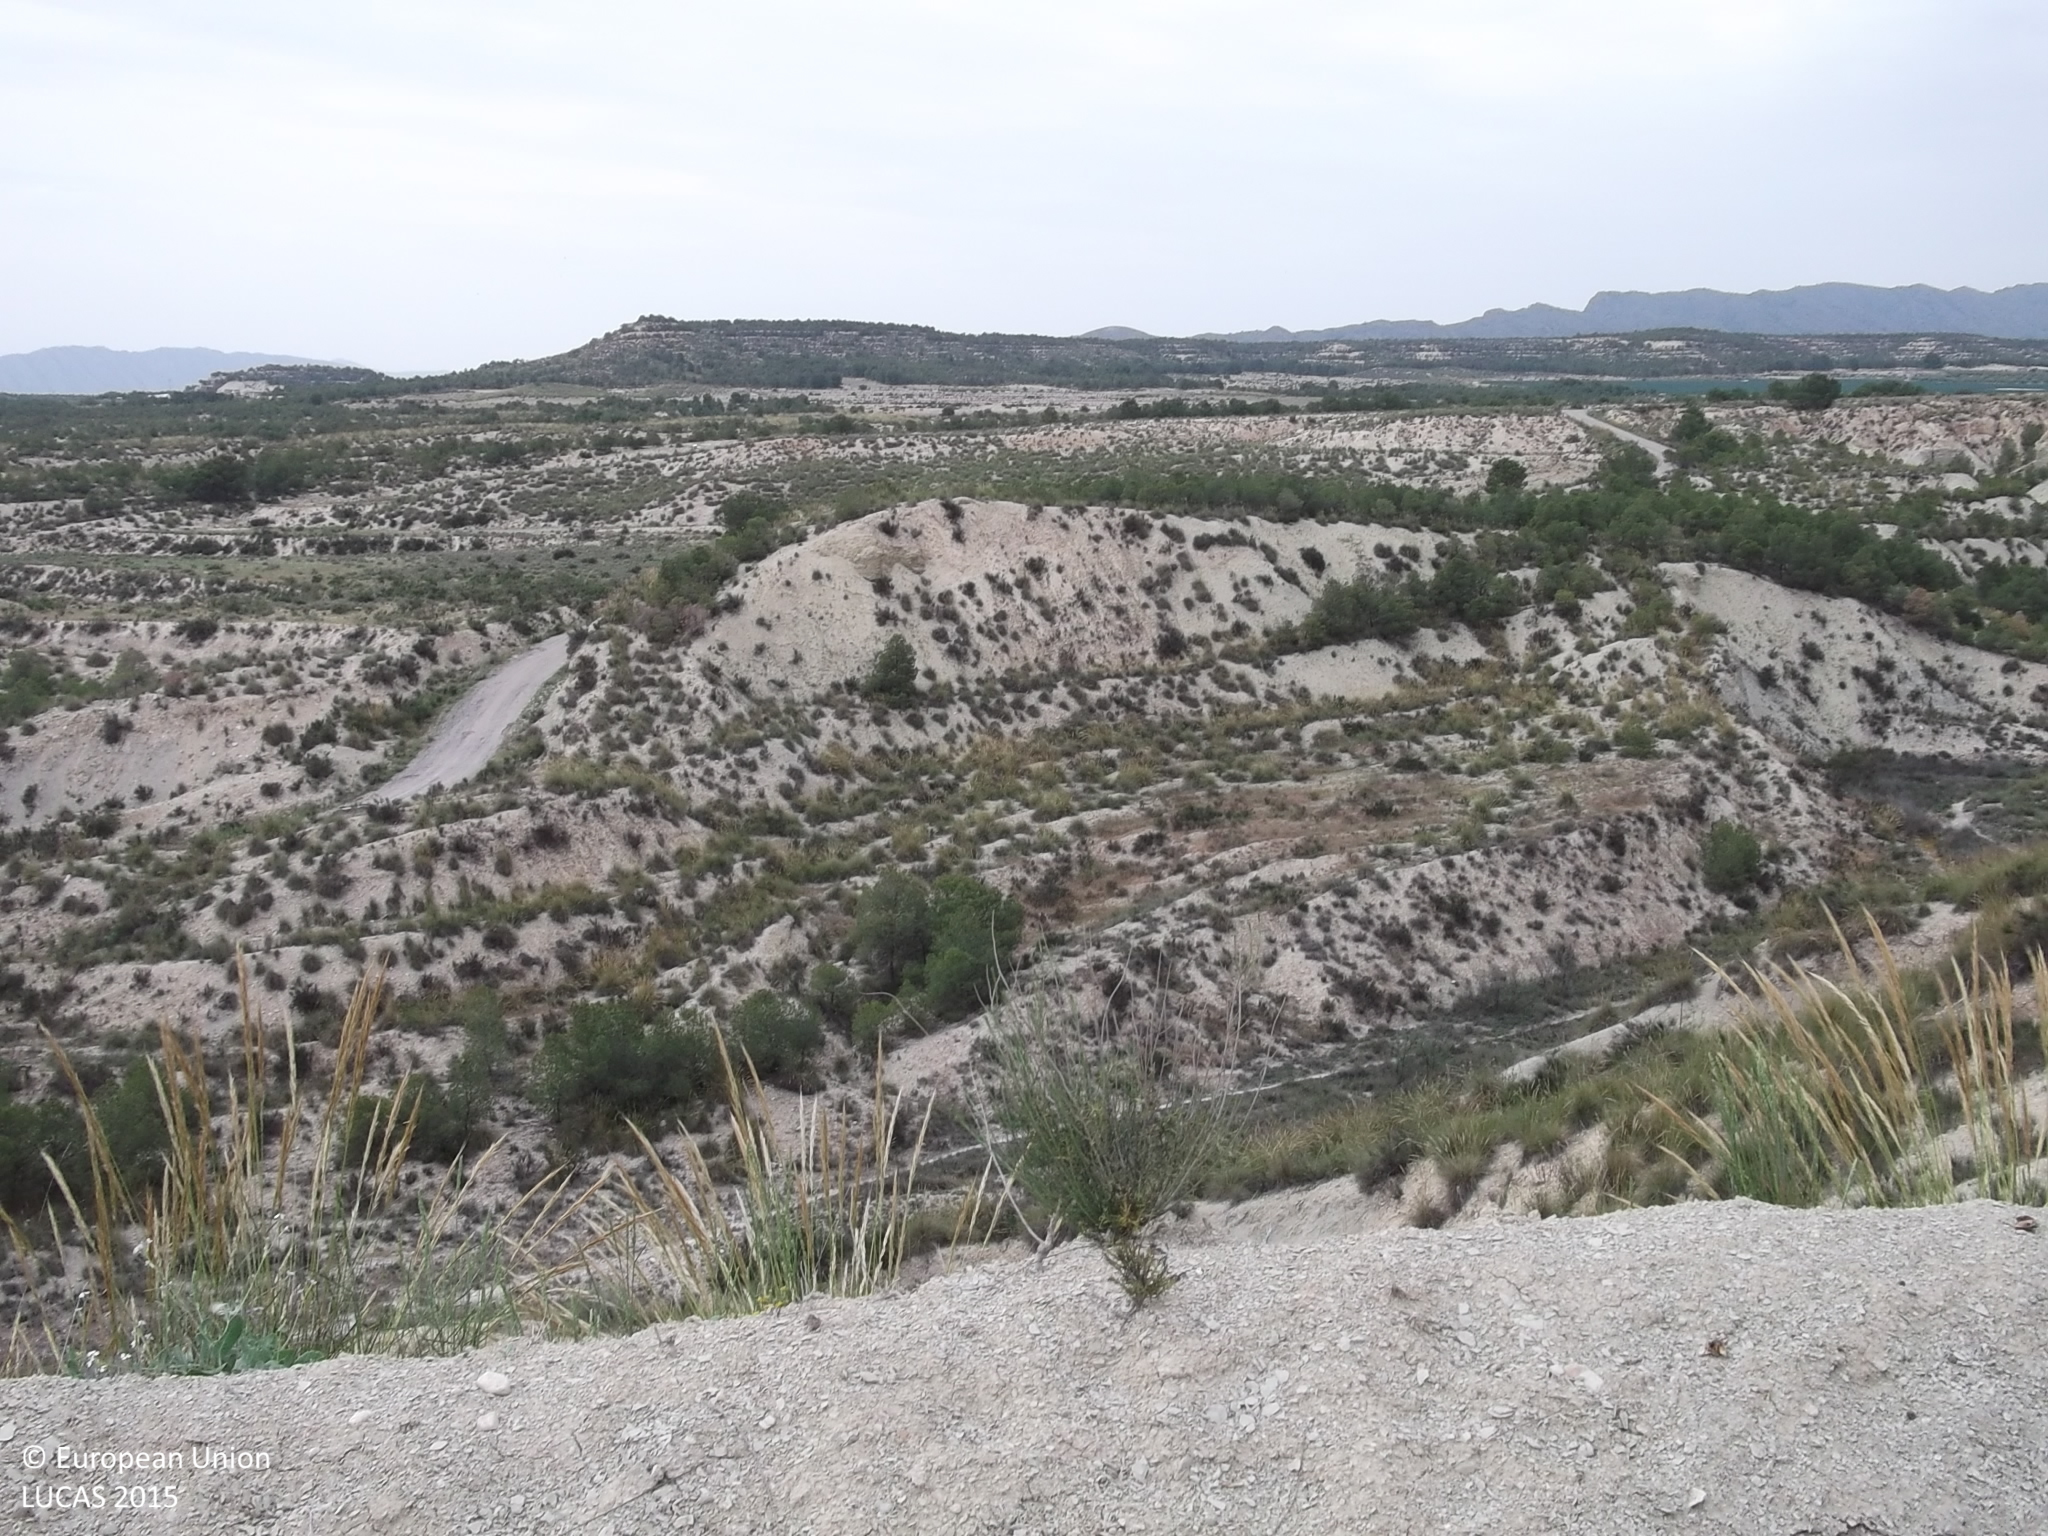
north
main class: Cropland
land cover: Other fruit trees and berries
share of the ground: < 10 %
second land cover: Other bare soil
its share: > 75 %
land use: Agriculture (excluding fallow land and kitchen gardens)
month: May
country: ES
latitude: 38.2840
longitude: -1.4097
